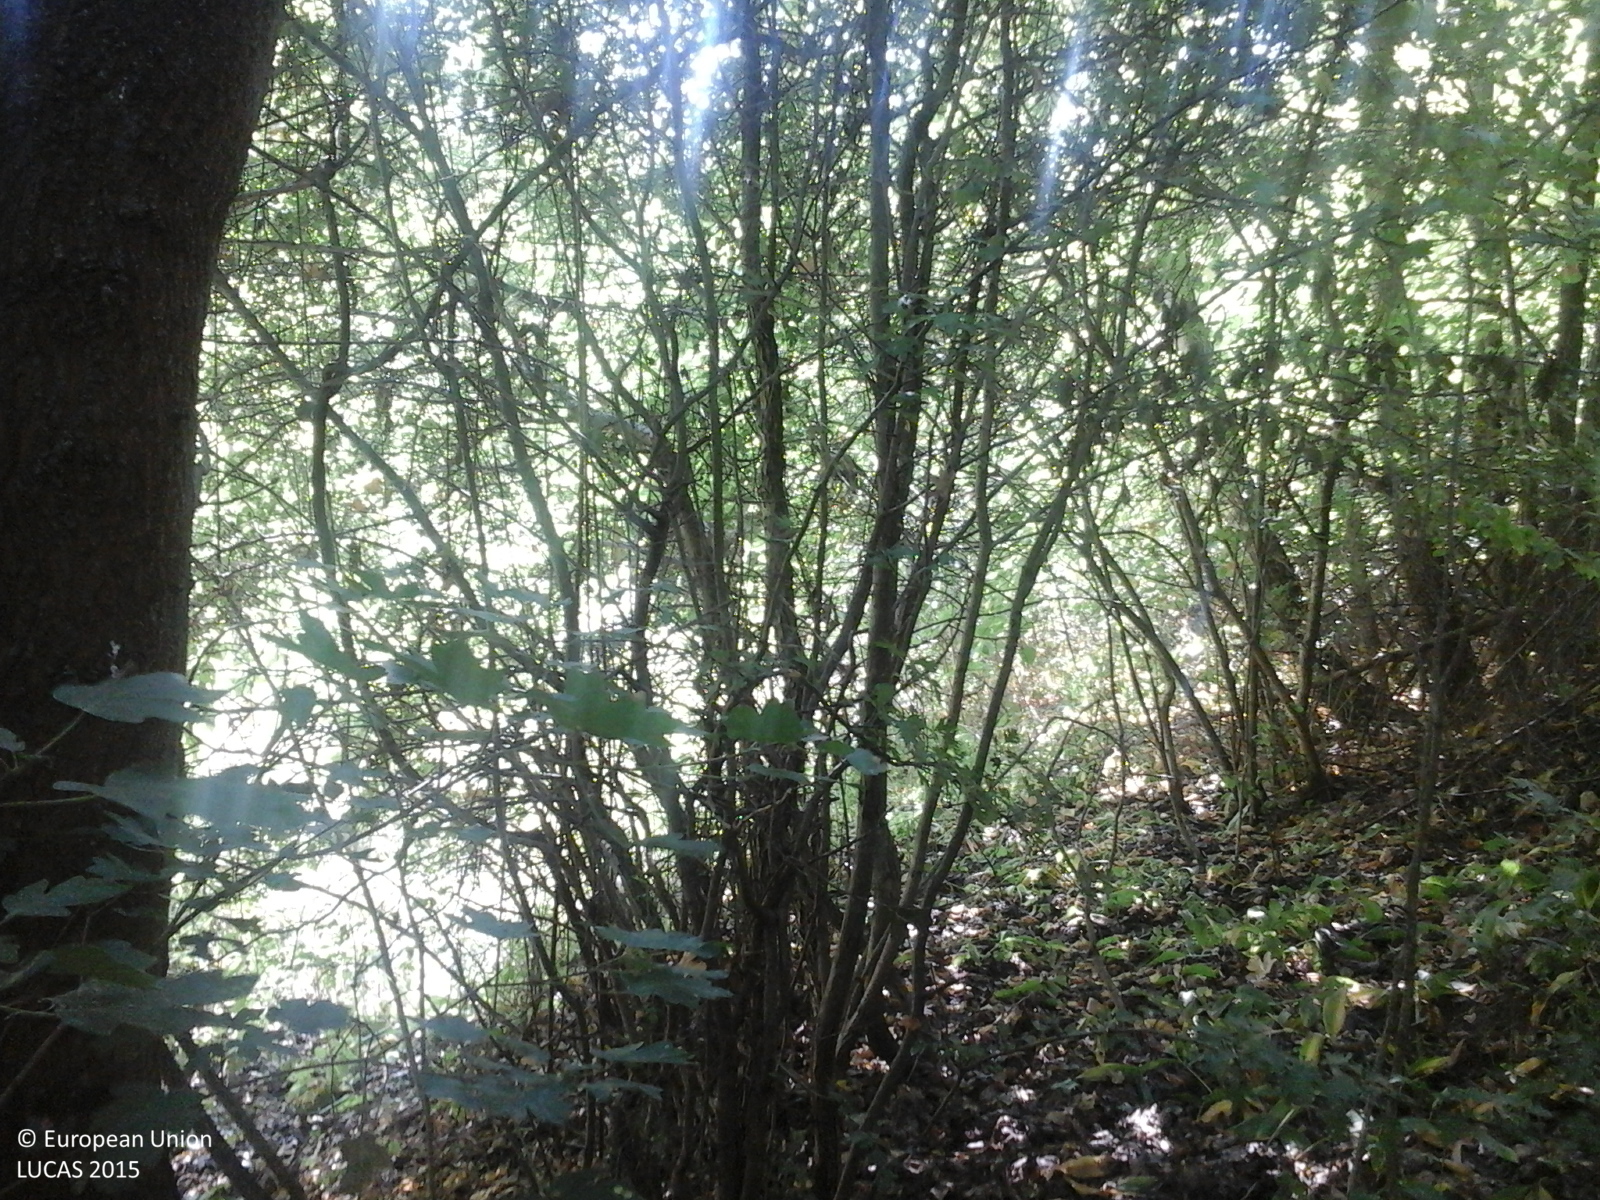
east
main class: Woodland
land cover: Spruce dominated coniferous woodland
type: alpine coniferous forest
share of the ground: > 75 %
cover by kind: coniferous forest trees 75 %, broadleaved forest trees 25 %
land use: Forestry
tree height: > 5 m
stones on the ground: 10 - 25 %
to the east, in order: Spruce dominated coniferous woodland; Abandoned hedges; Ditches and canals; Abandoned hedges; Inland marshes; Grassland without tree/shrub cover
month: July
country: RO
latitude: 46.6110
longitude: 27.2476
